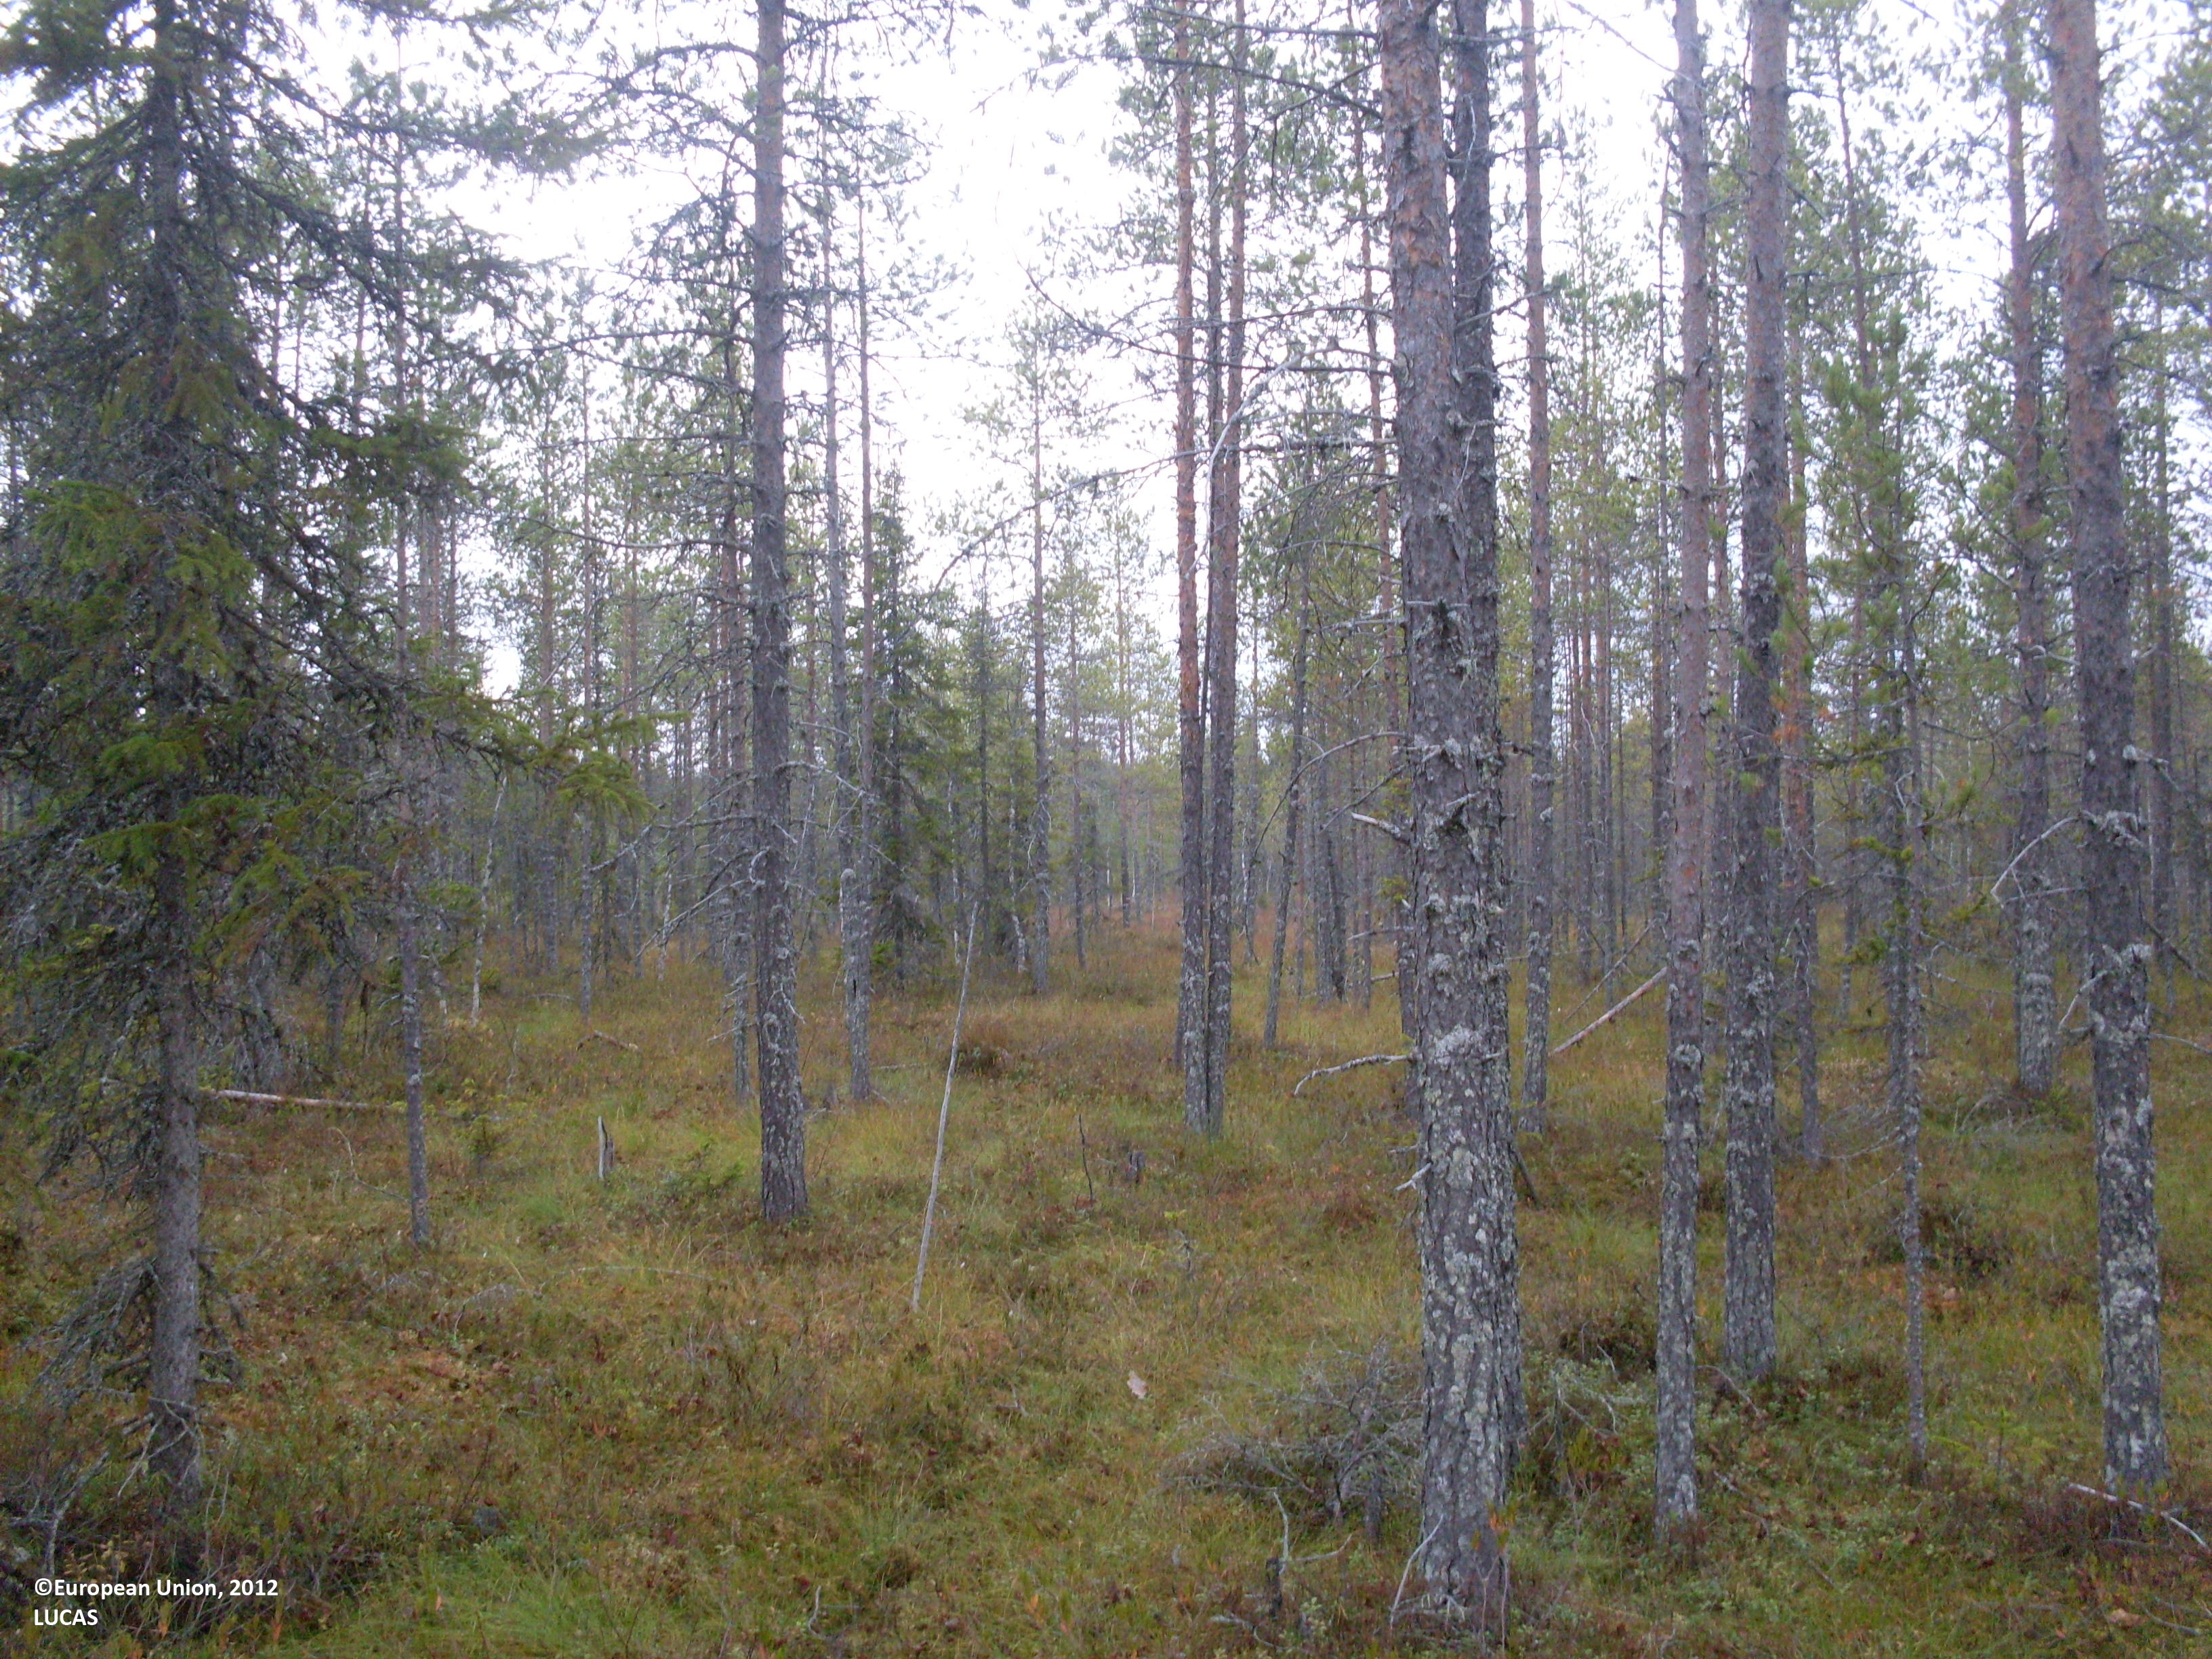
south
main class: Woodland
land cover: Pine dominated coniferous woodland
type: boreal forest
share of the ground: 25 - 50 %
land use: Forestry
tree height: > 5 m
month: September
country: FI
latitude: 64.5513
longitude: 29.6800
